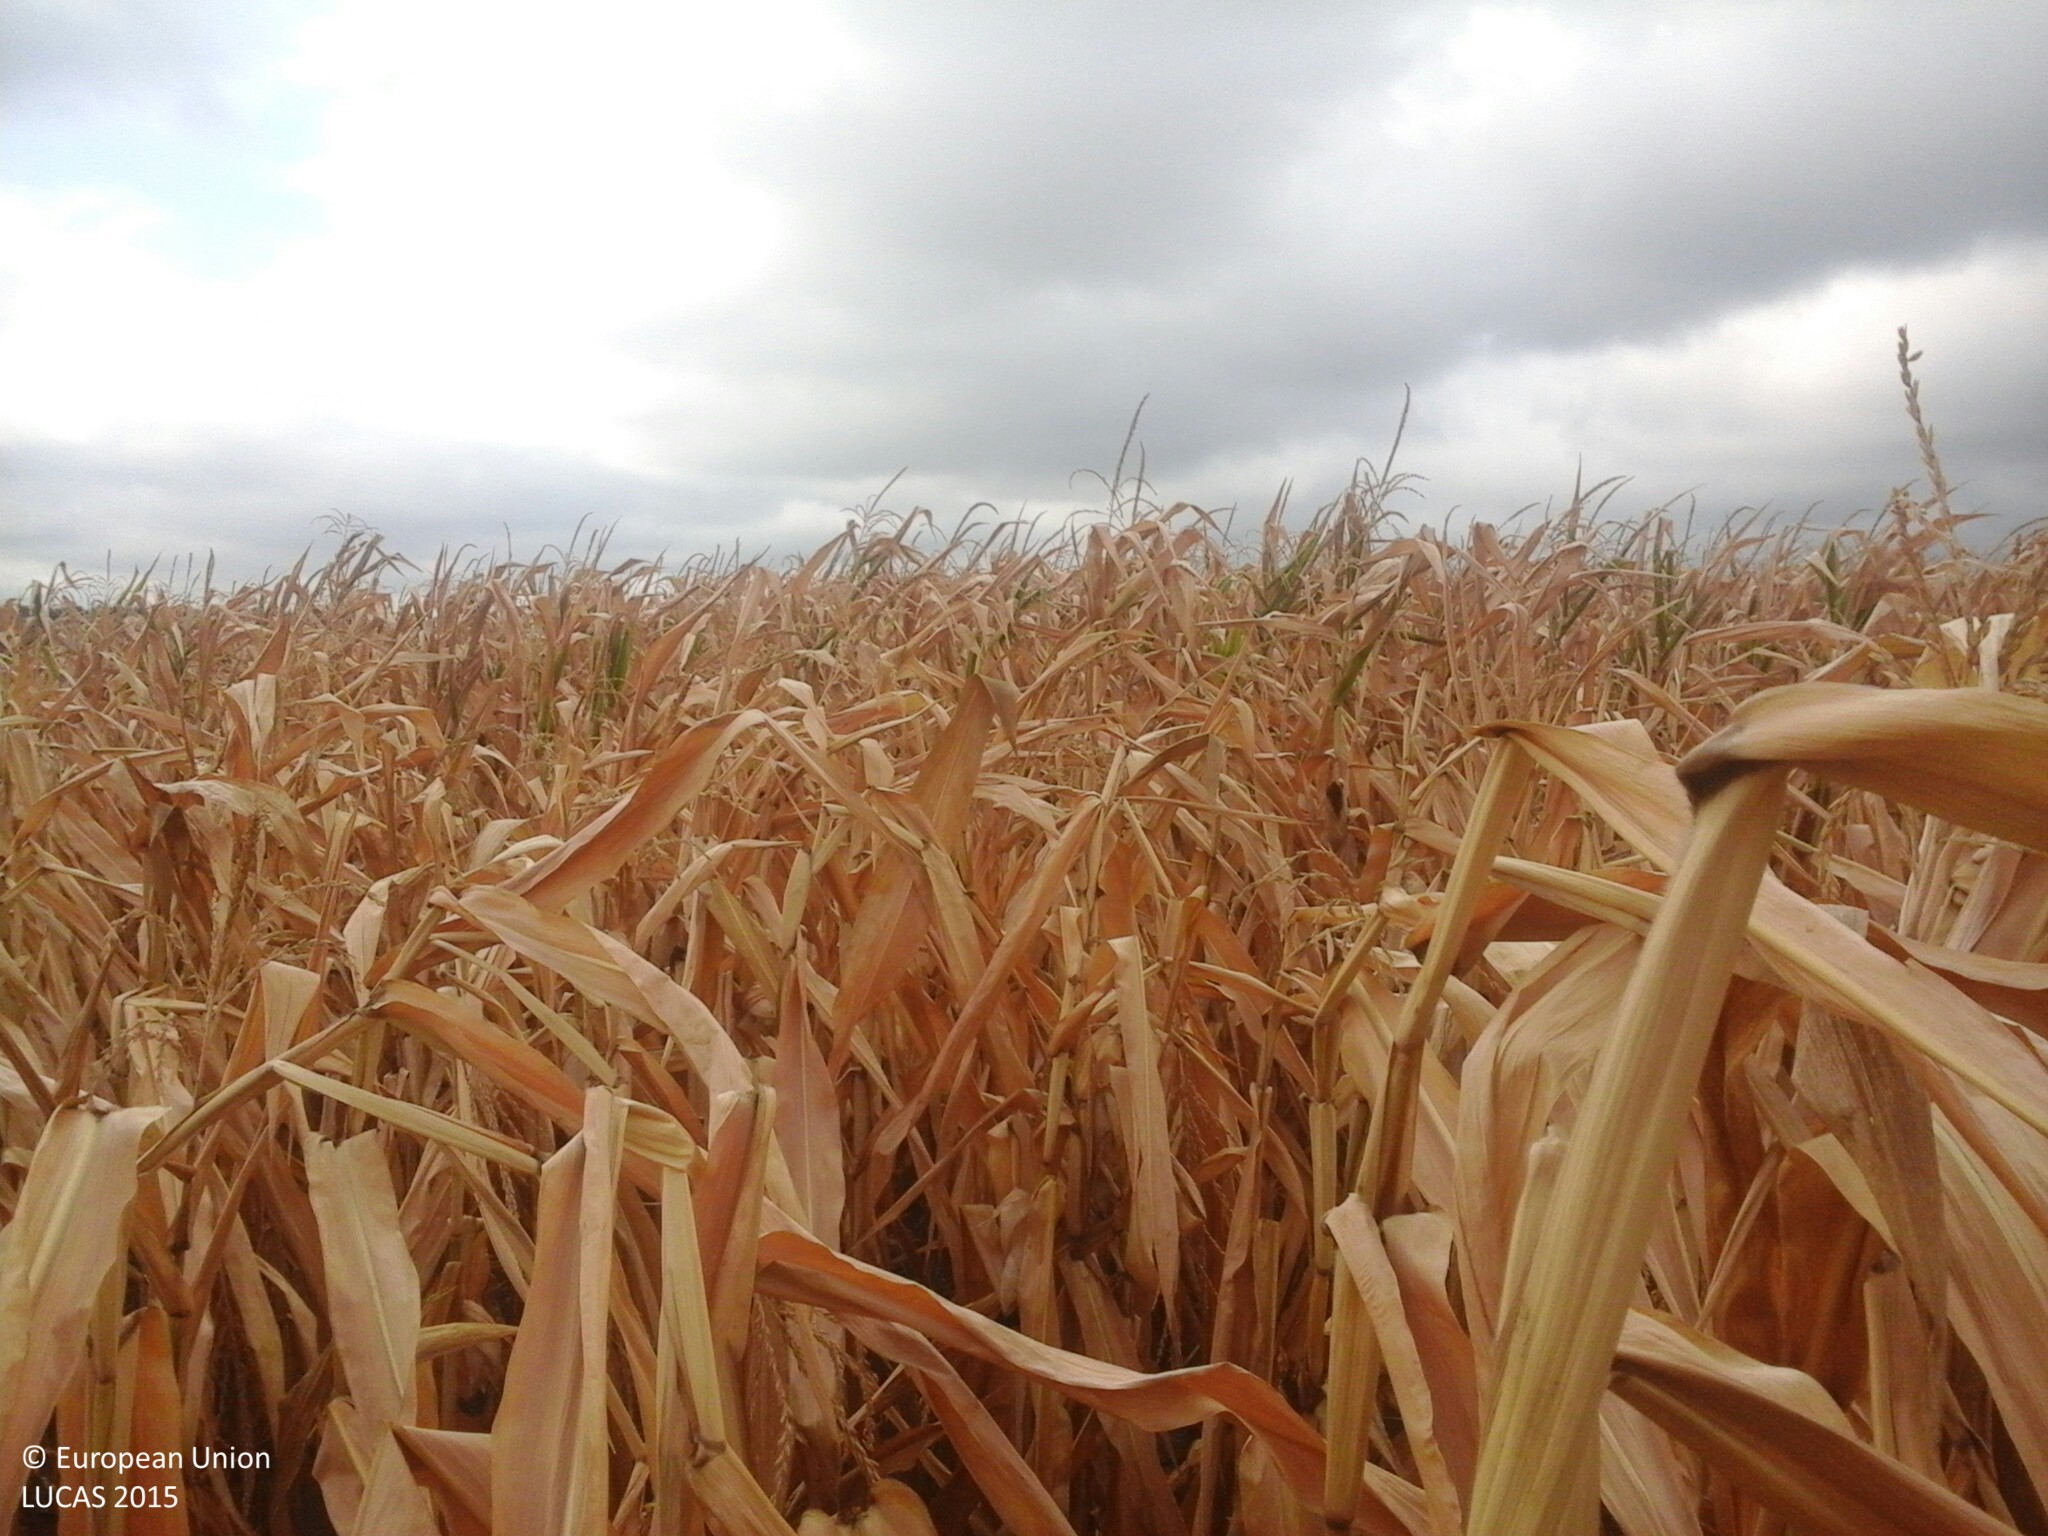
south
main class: Cropland
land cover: Maize
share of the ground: > 75 %
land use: Agriculture (excluding fallow land and kitchen gardens)
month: August
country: HU
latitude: 47.0497
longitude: 21.5593
